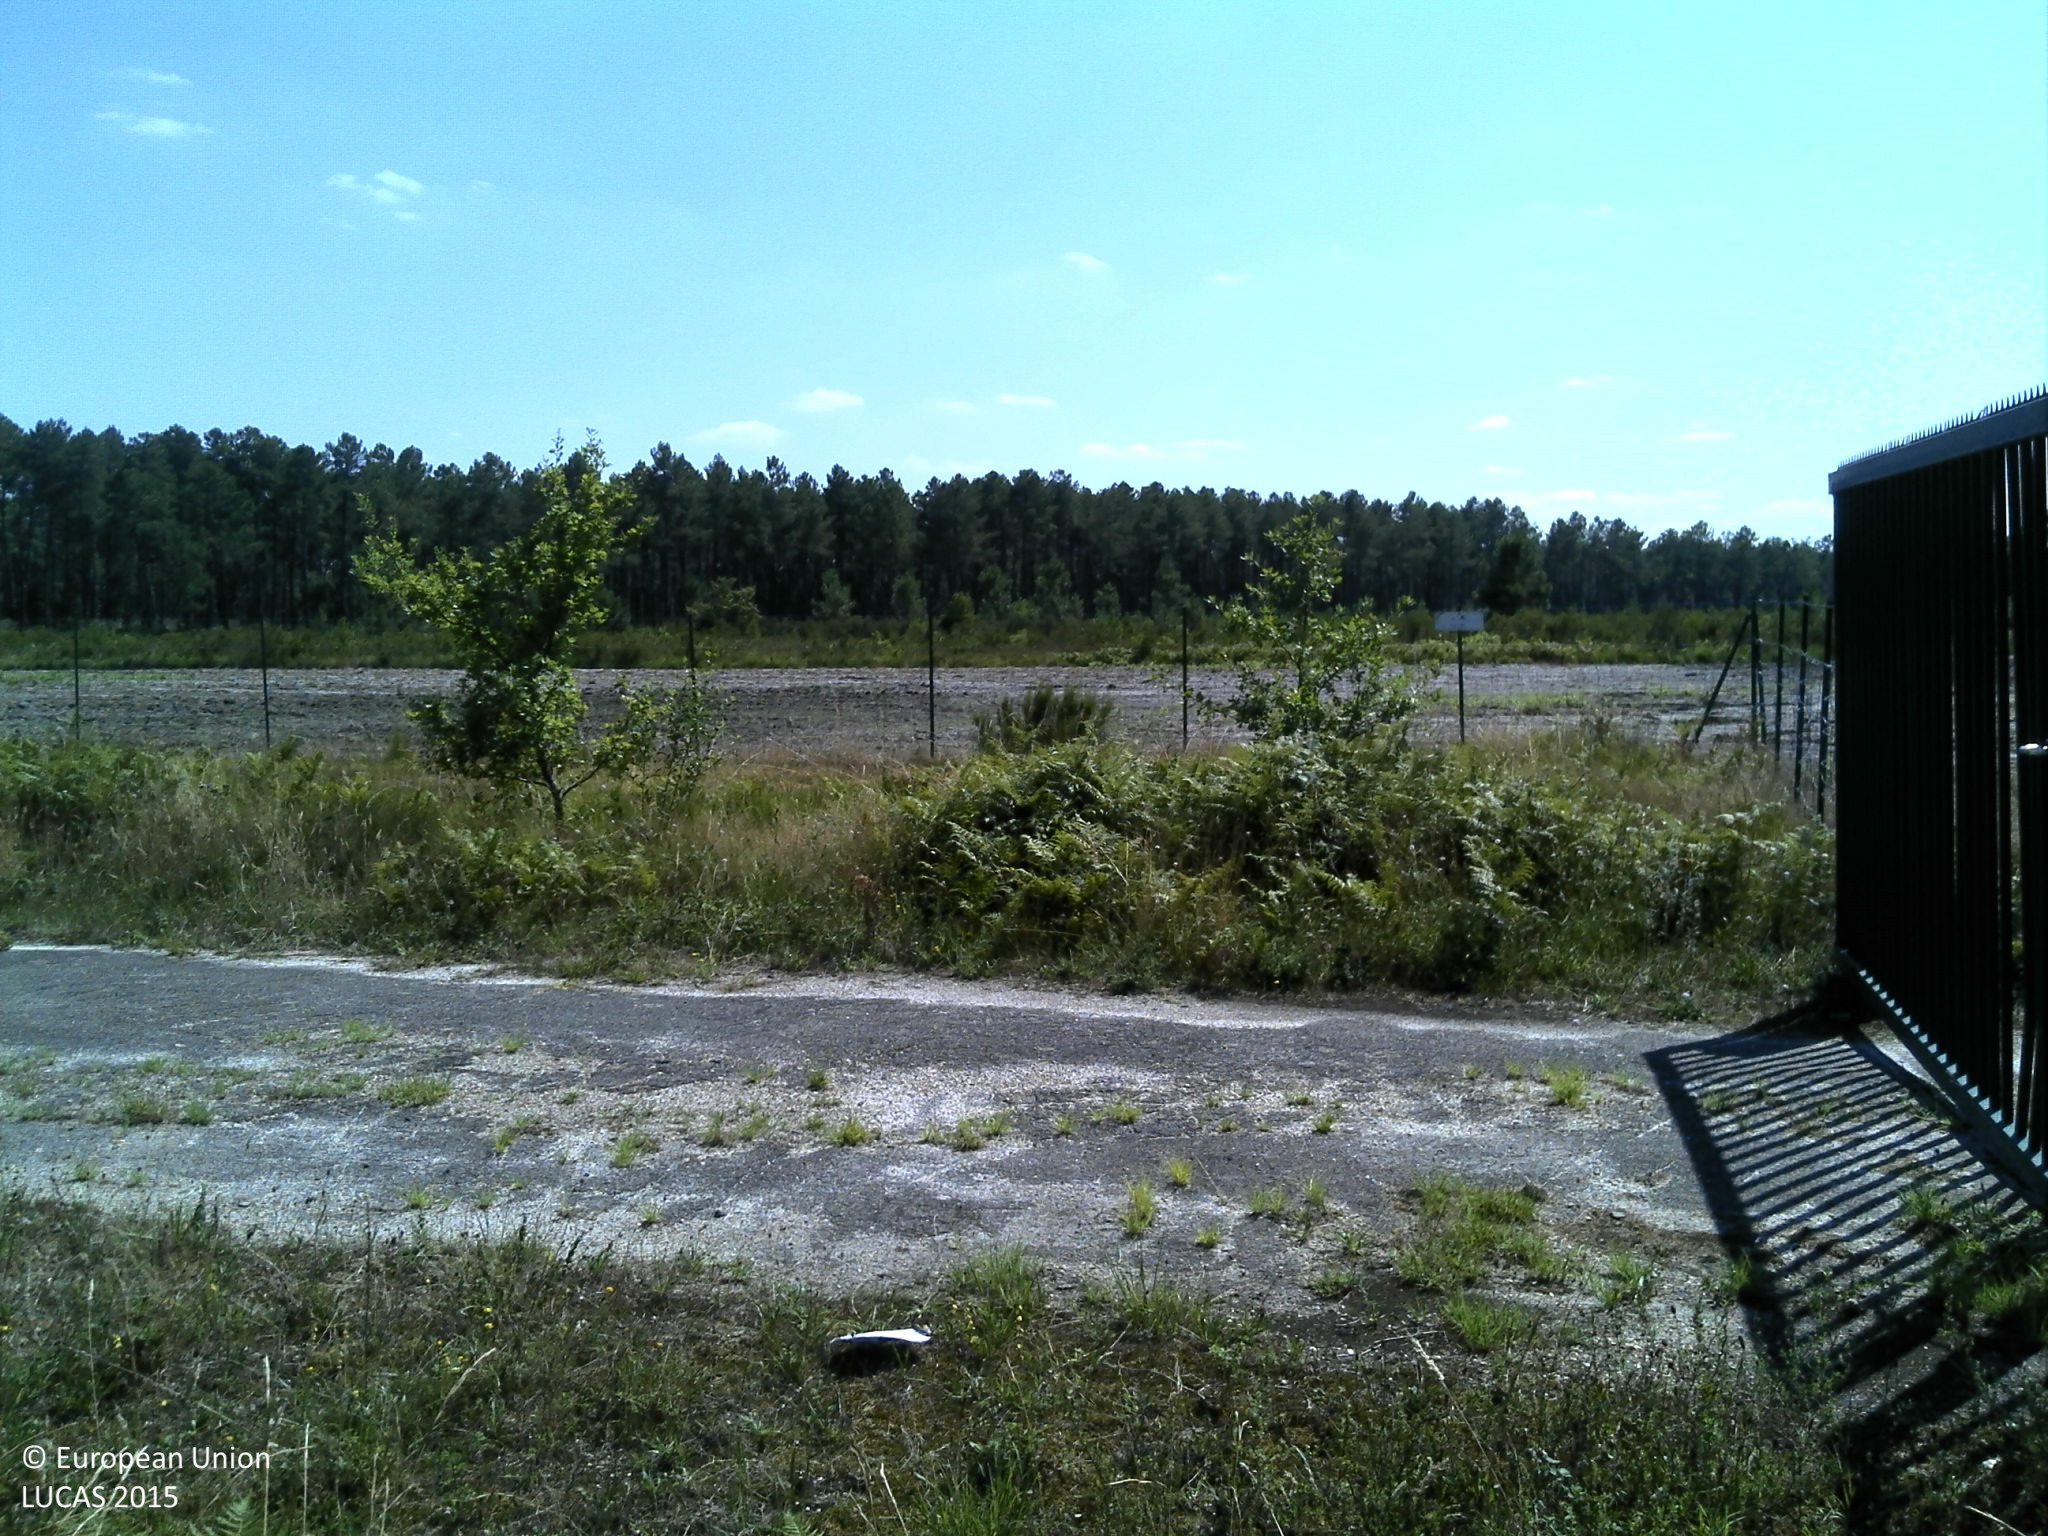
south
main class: Grassland
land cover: Spontaneously vegetated surfaces
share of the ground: > 75 %
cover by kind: herbaceous plants 95 %, shrubs 5 %
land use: Community services
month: August
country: FR
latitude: 44.2169
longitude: -0.3135
